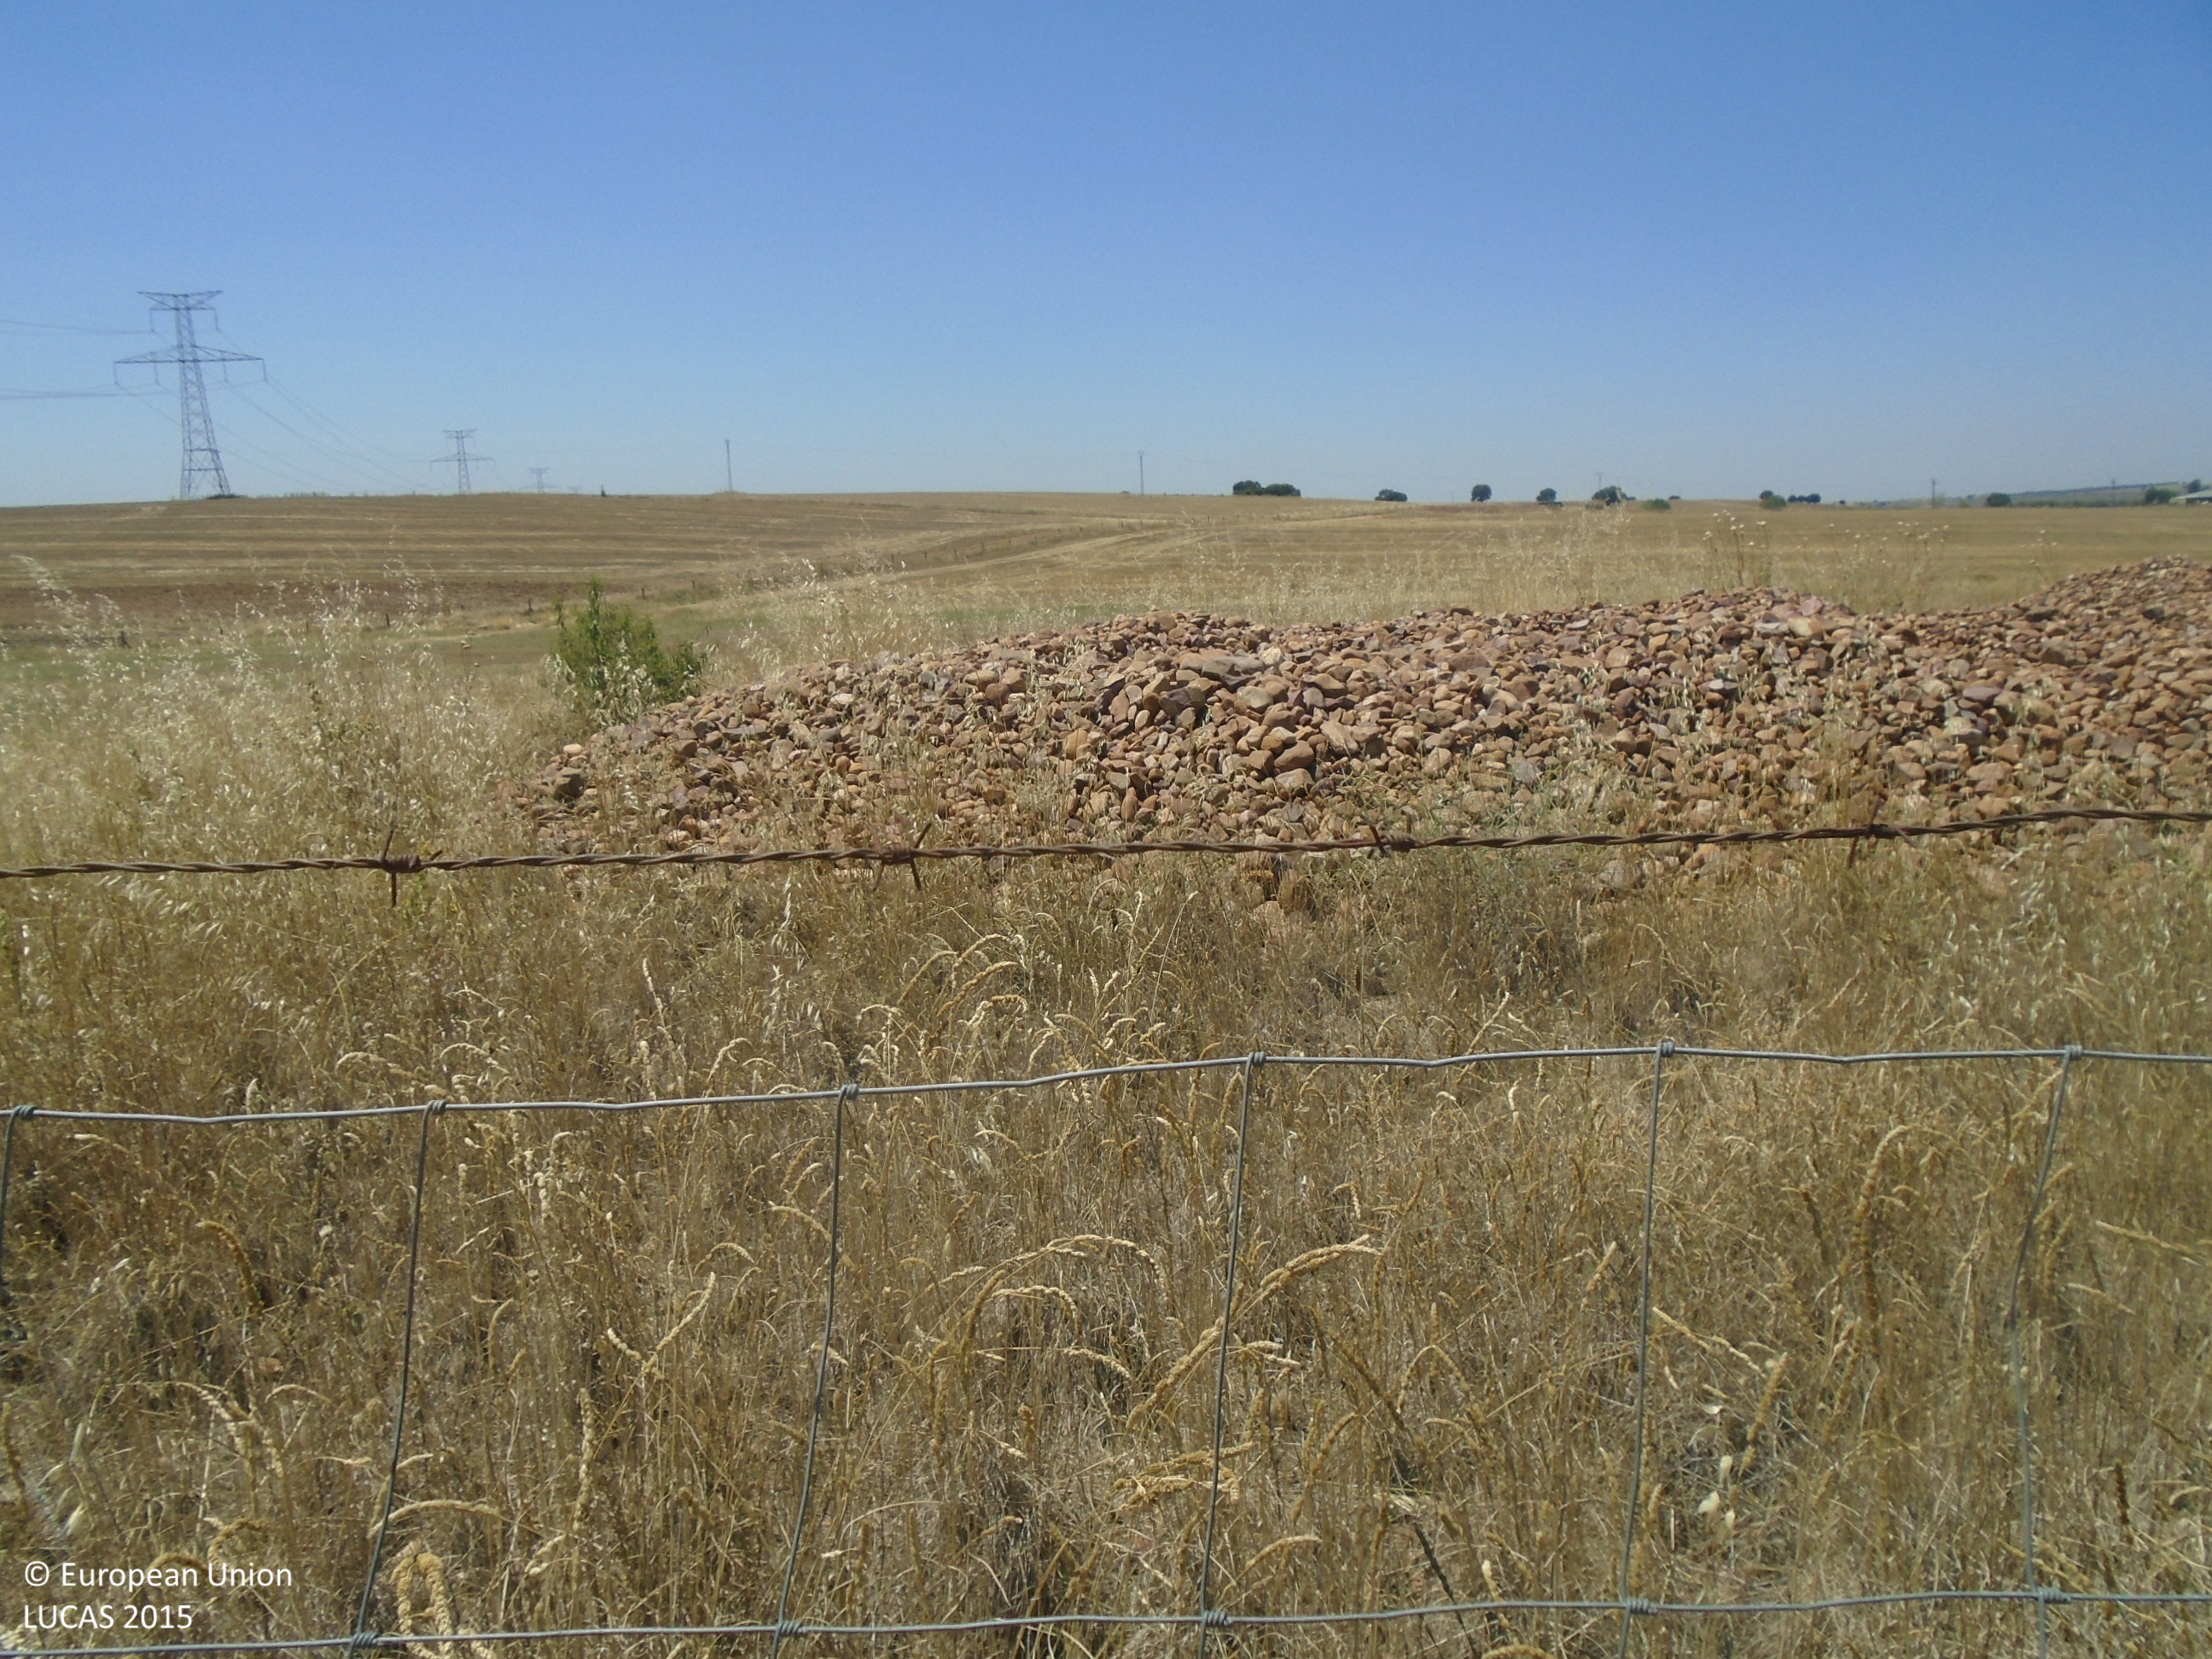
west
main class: Cropland
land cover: Barley
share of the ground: > 75 %
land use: Agriculture (excluding fallow land and kitchen gardens)
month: July
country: ES
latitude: 39.8032
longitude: -4.8915
